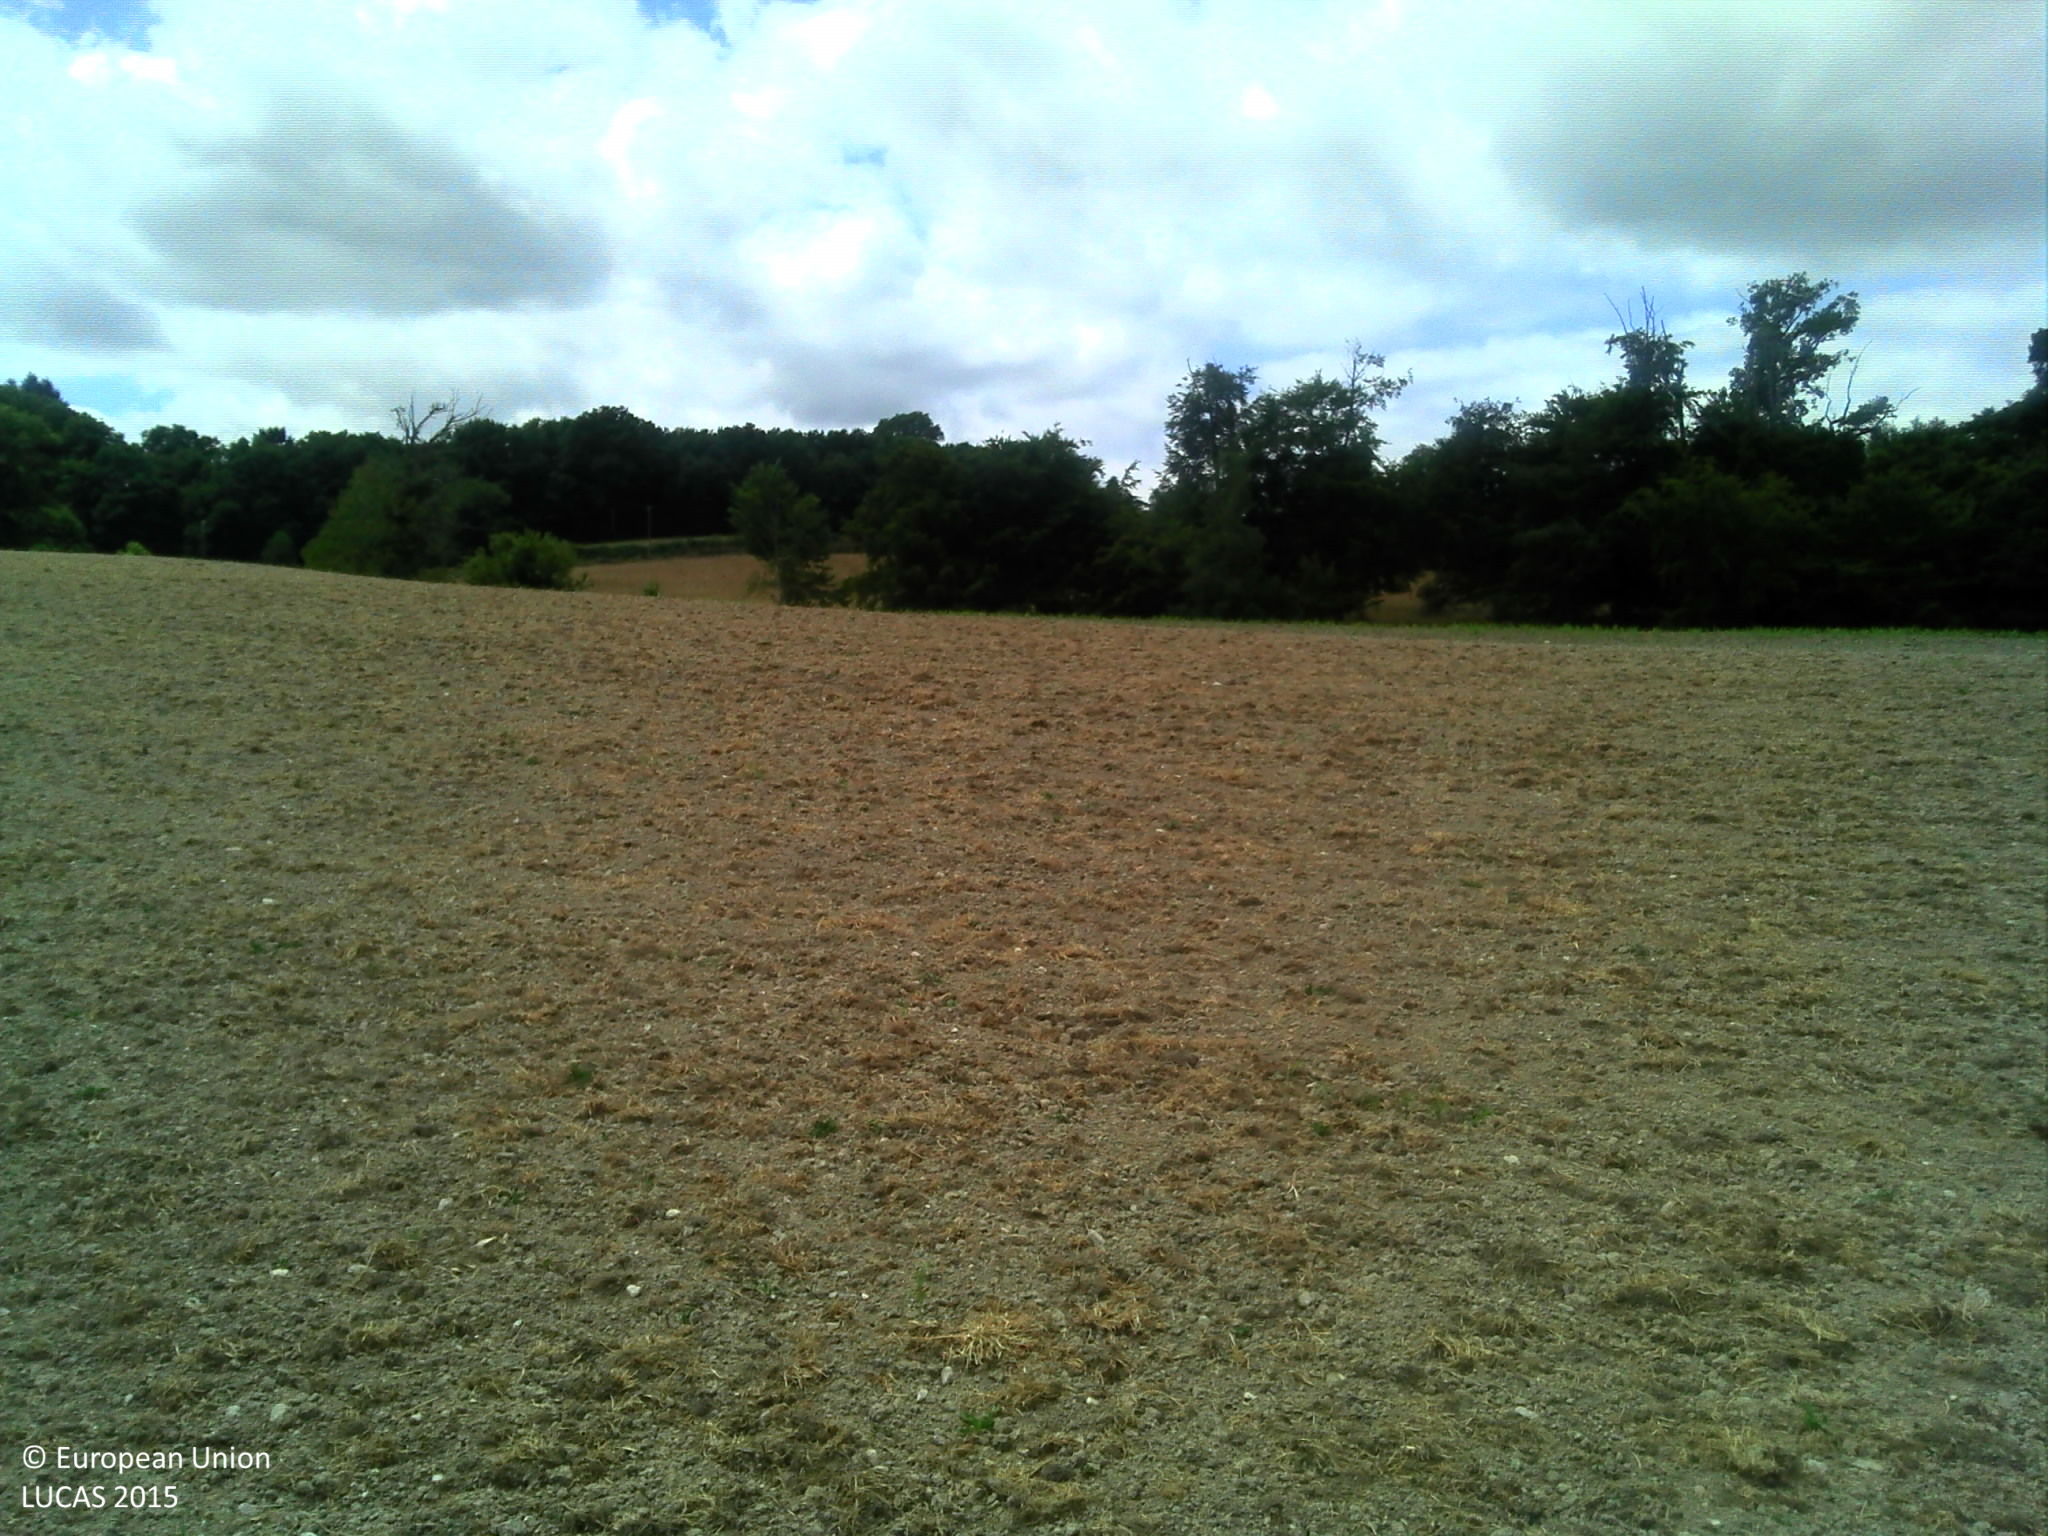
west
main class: Cropland
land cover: Other cereals
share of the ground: < 10 %
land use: Agriculture (excluding fallow land and kitchen gardens)
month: July
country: FR
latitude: 46.3848
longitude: 1.6301
